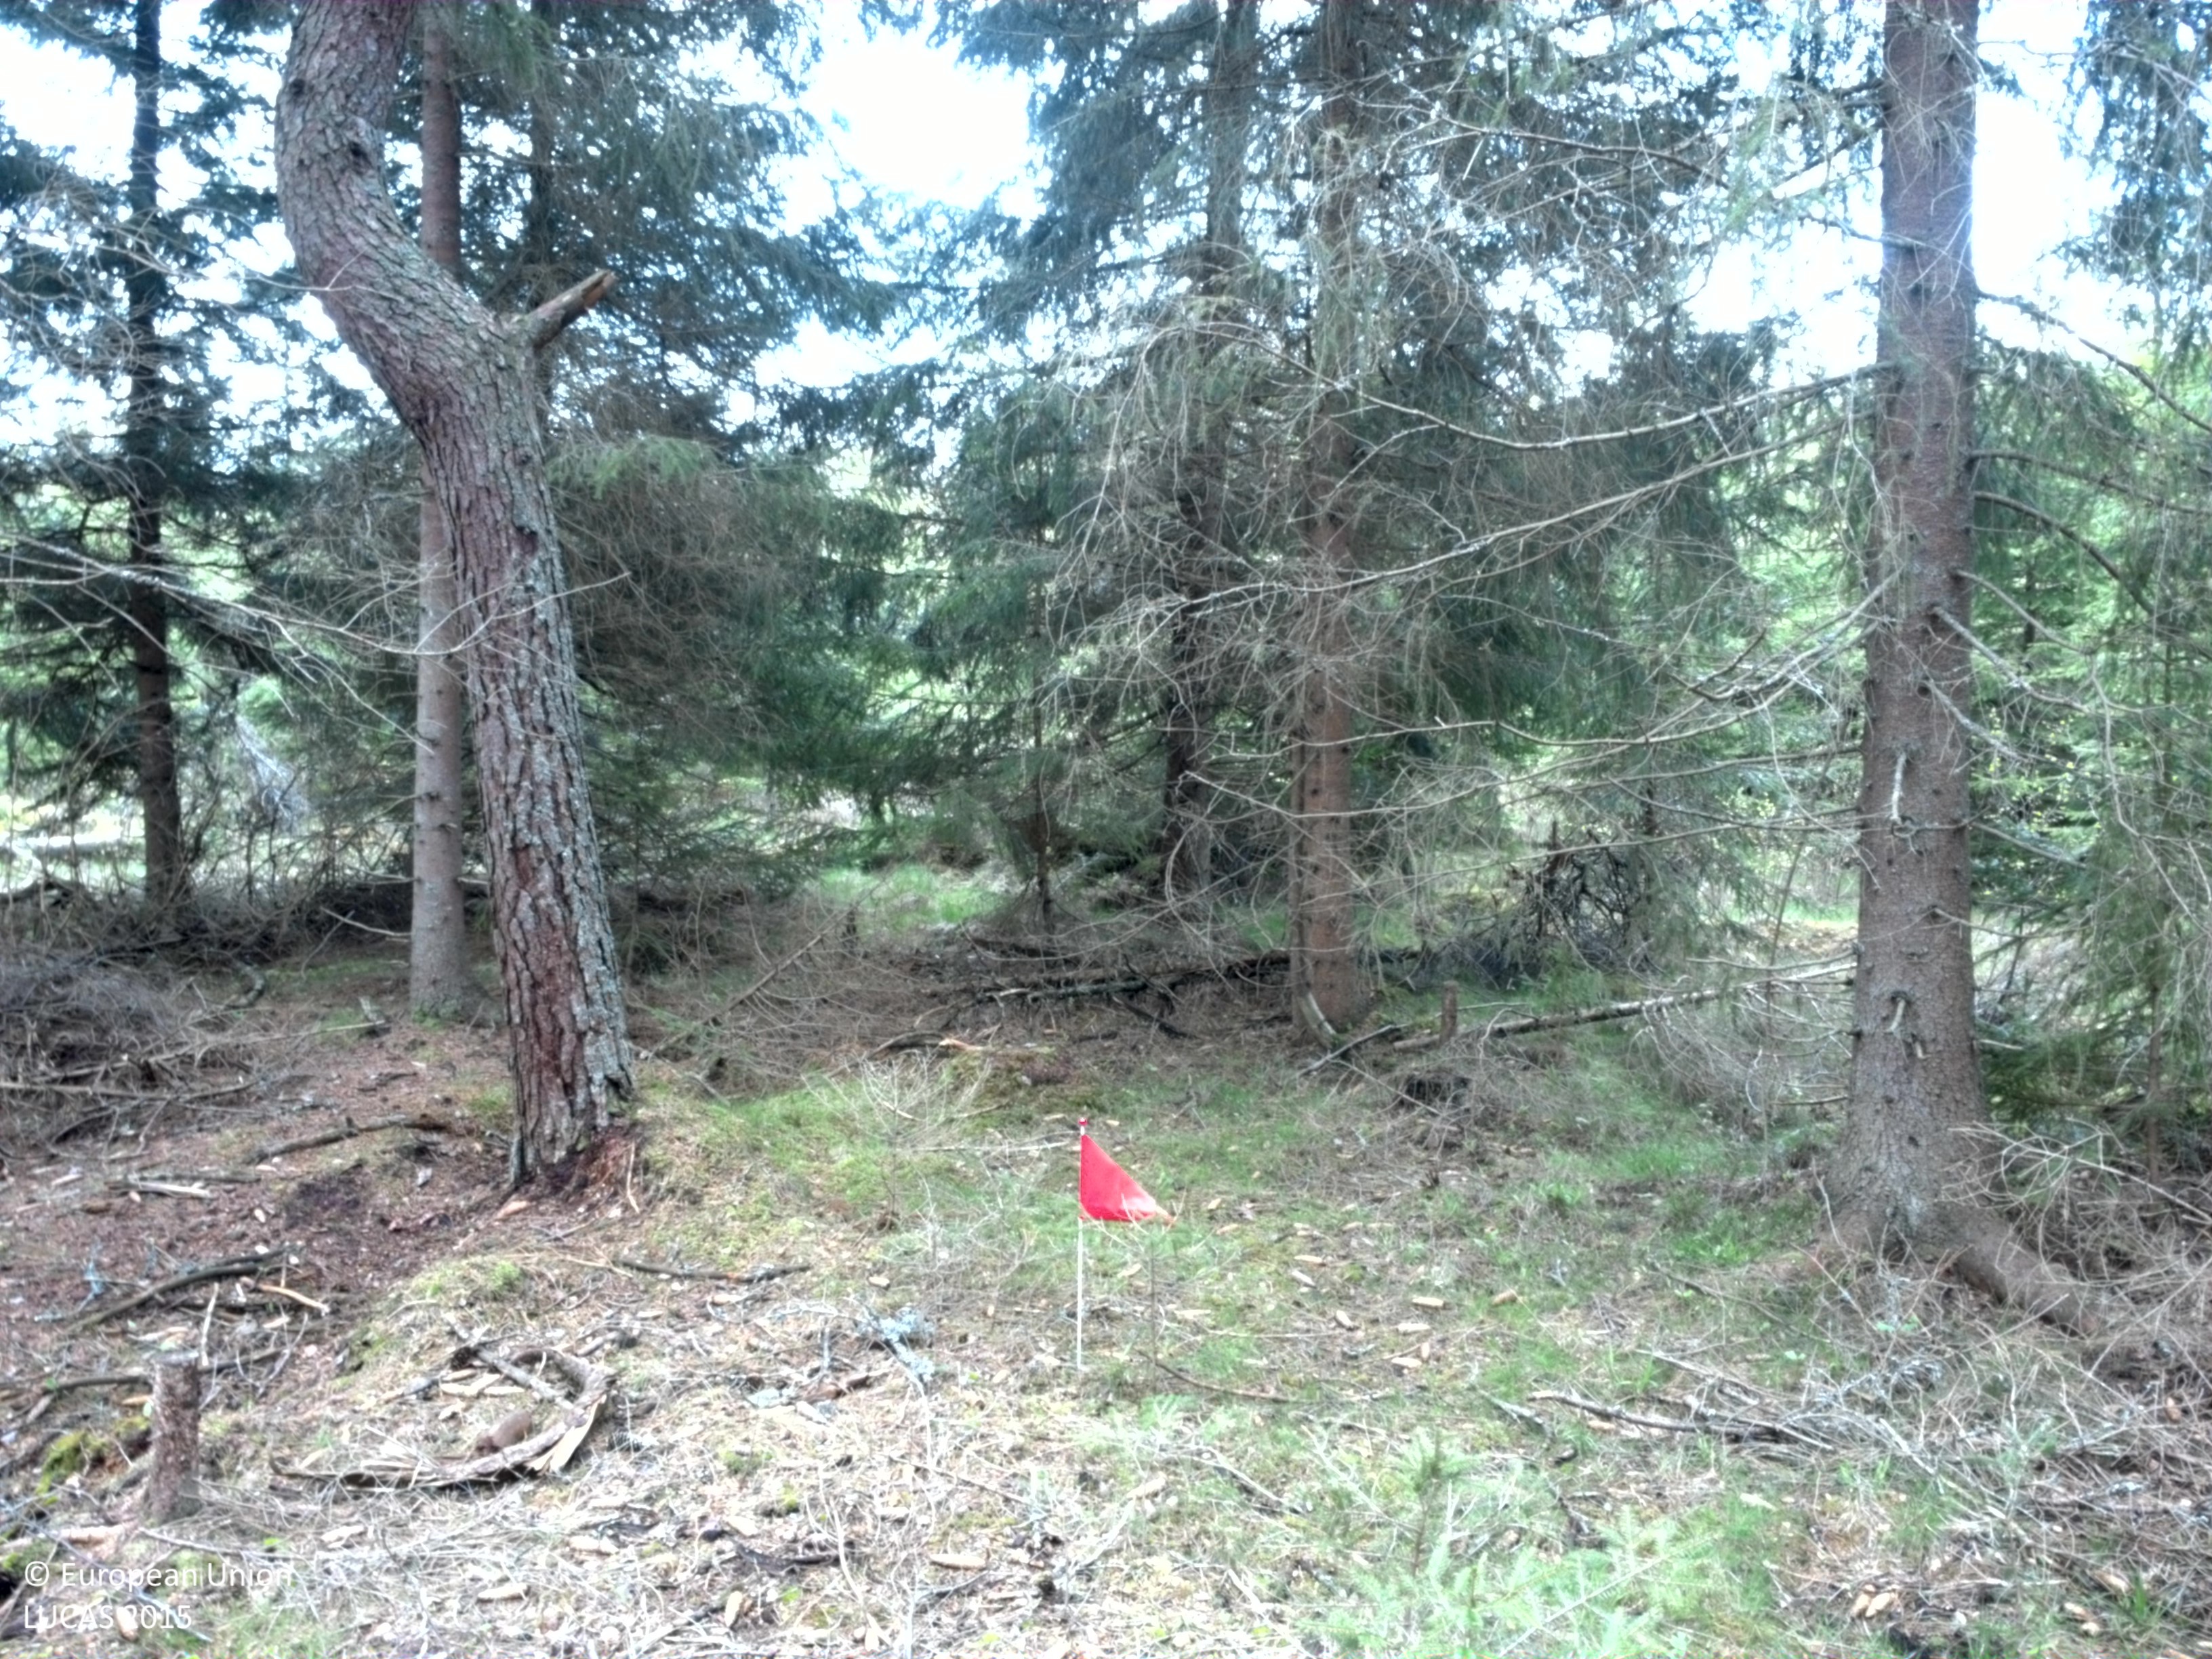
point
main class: Woodland
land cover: Spruce dominated coniferous woodland
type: boreal forest
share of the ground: 50 - 75 %
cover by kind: coniferous forest trees 50 %, herbaceous plants 15 %, broadleaved forest trees 10 %, lichens and mosses 10 %, unconsolidated bare surface 10 %, shrubs 5 %
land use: Forestry
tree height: > 5 m
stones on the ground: < 10 %
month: May
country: SE
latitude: 56.8075
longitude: 15.0913
